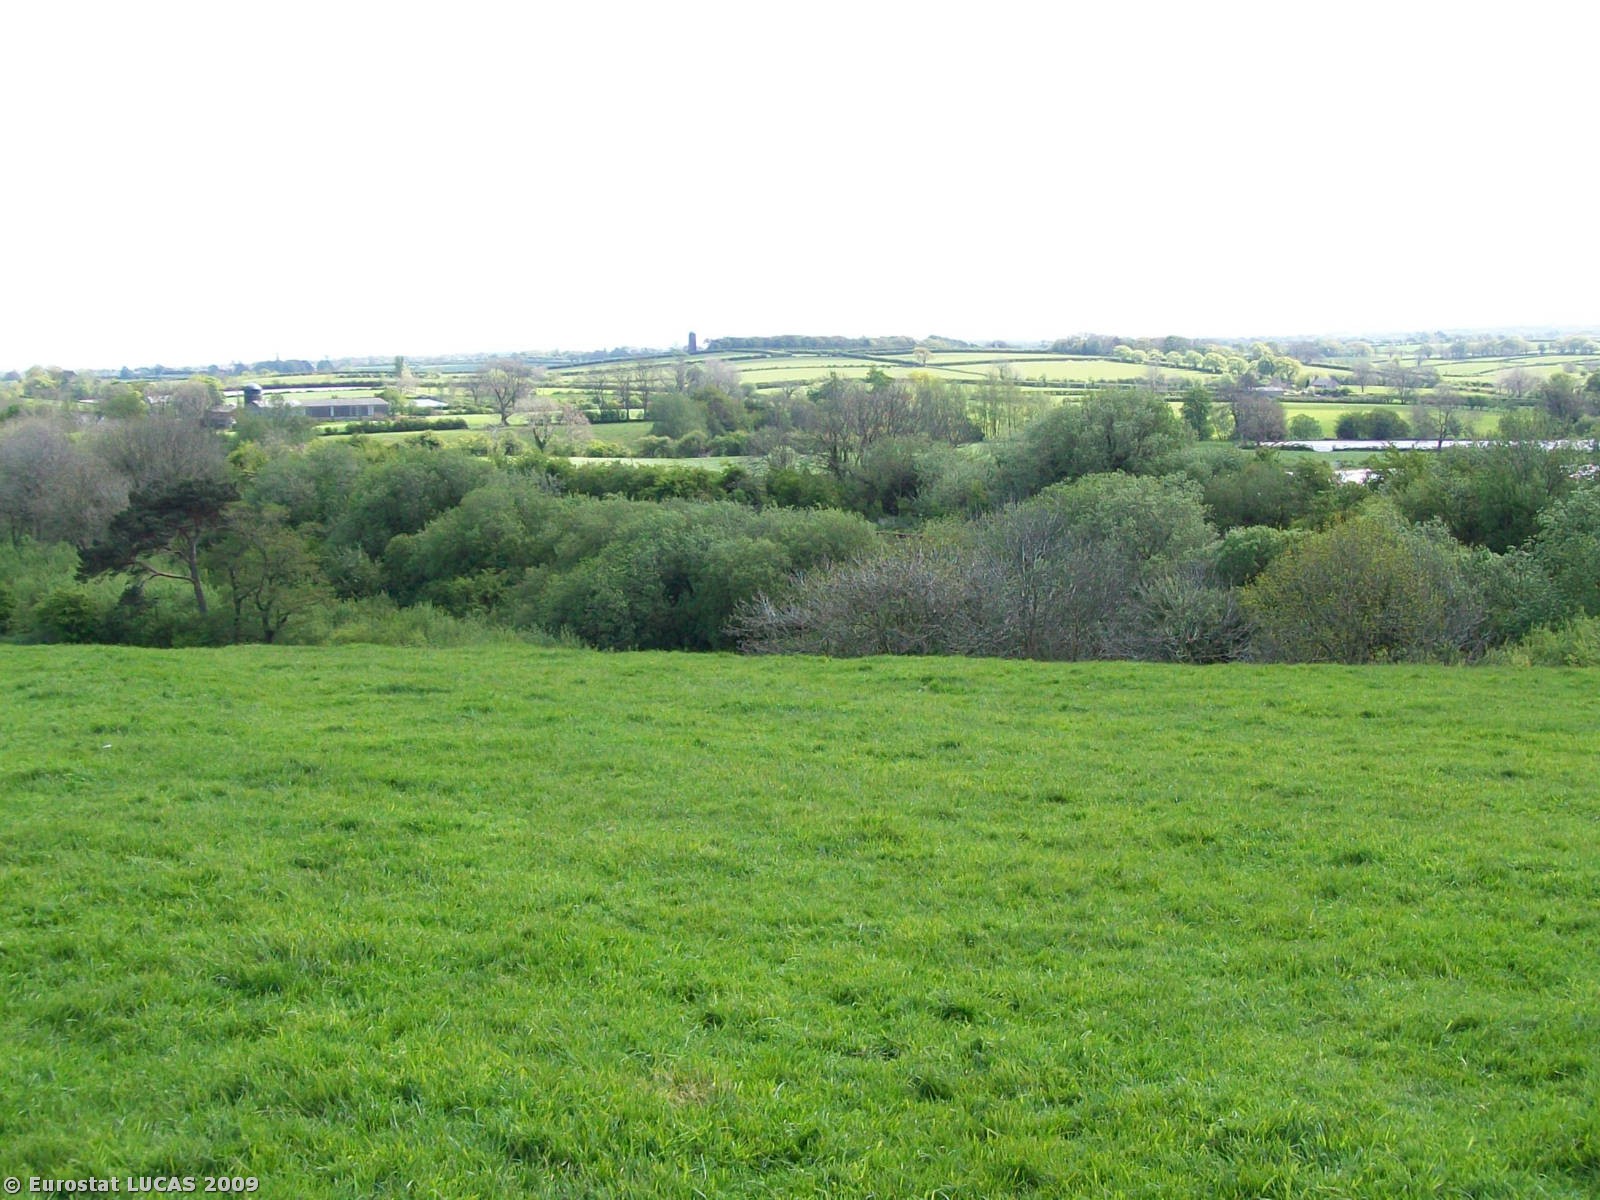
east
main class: Grassland
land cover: Grassland without tree/shrub cover
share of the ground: > 75 %
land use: Agriculture (excluding fallow land and kitchen gardens)
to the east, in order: Grassland without tree/shrub cover; Fences; Broadleaved woodland; Railways; Broadleaved woodland; Ditches and canals; Fences; Temporary grasslands
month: May
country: GB
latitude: 54.8063
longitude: -3.2224
